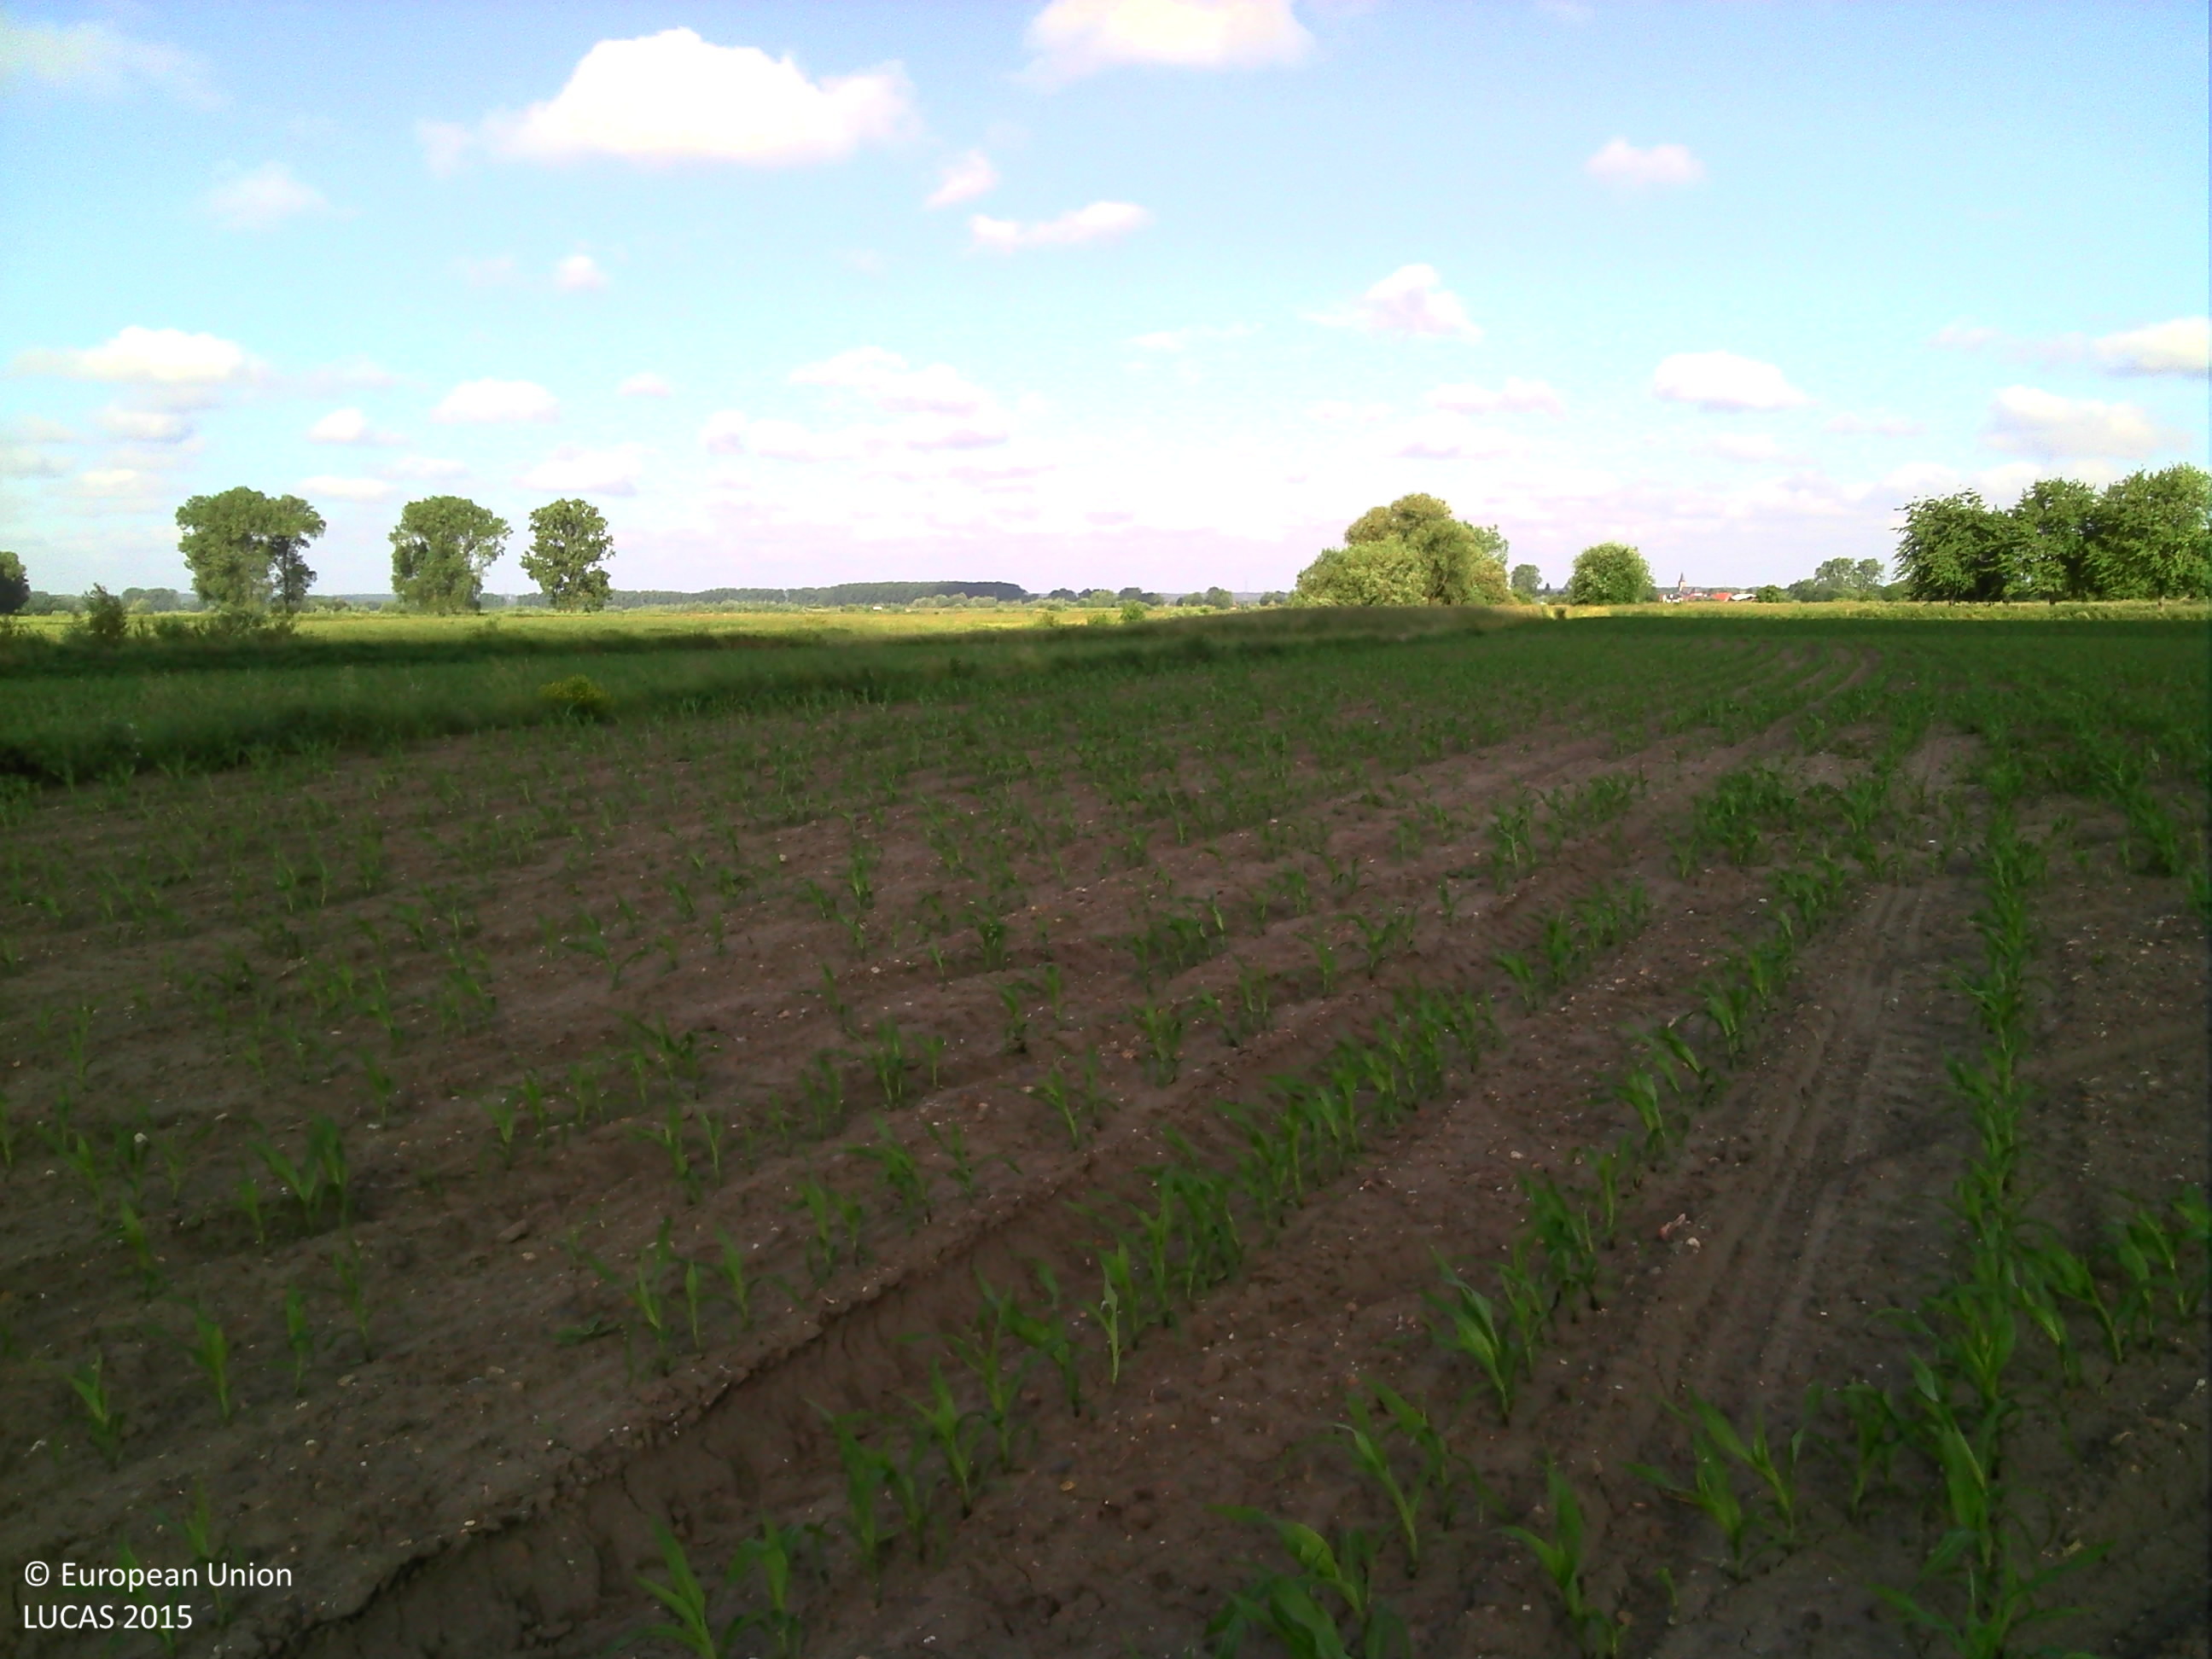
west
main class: Cropland
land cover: Maize
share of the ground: 10 - 25 %
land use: Agriculture (excluding fallow land and kitchen gardens)
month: June
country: BE
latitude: 51.0608
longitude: 5.7895
